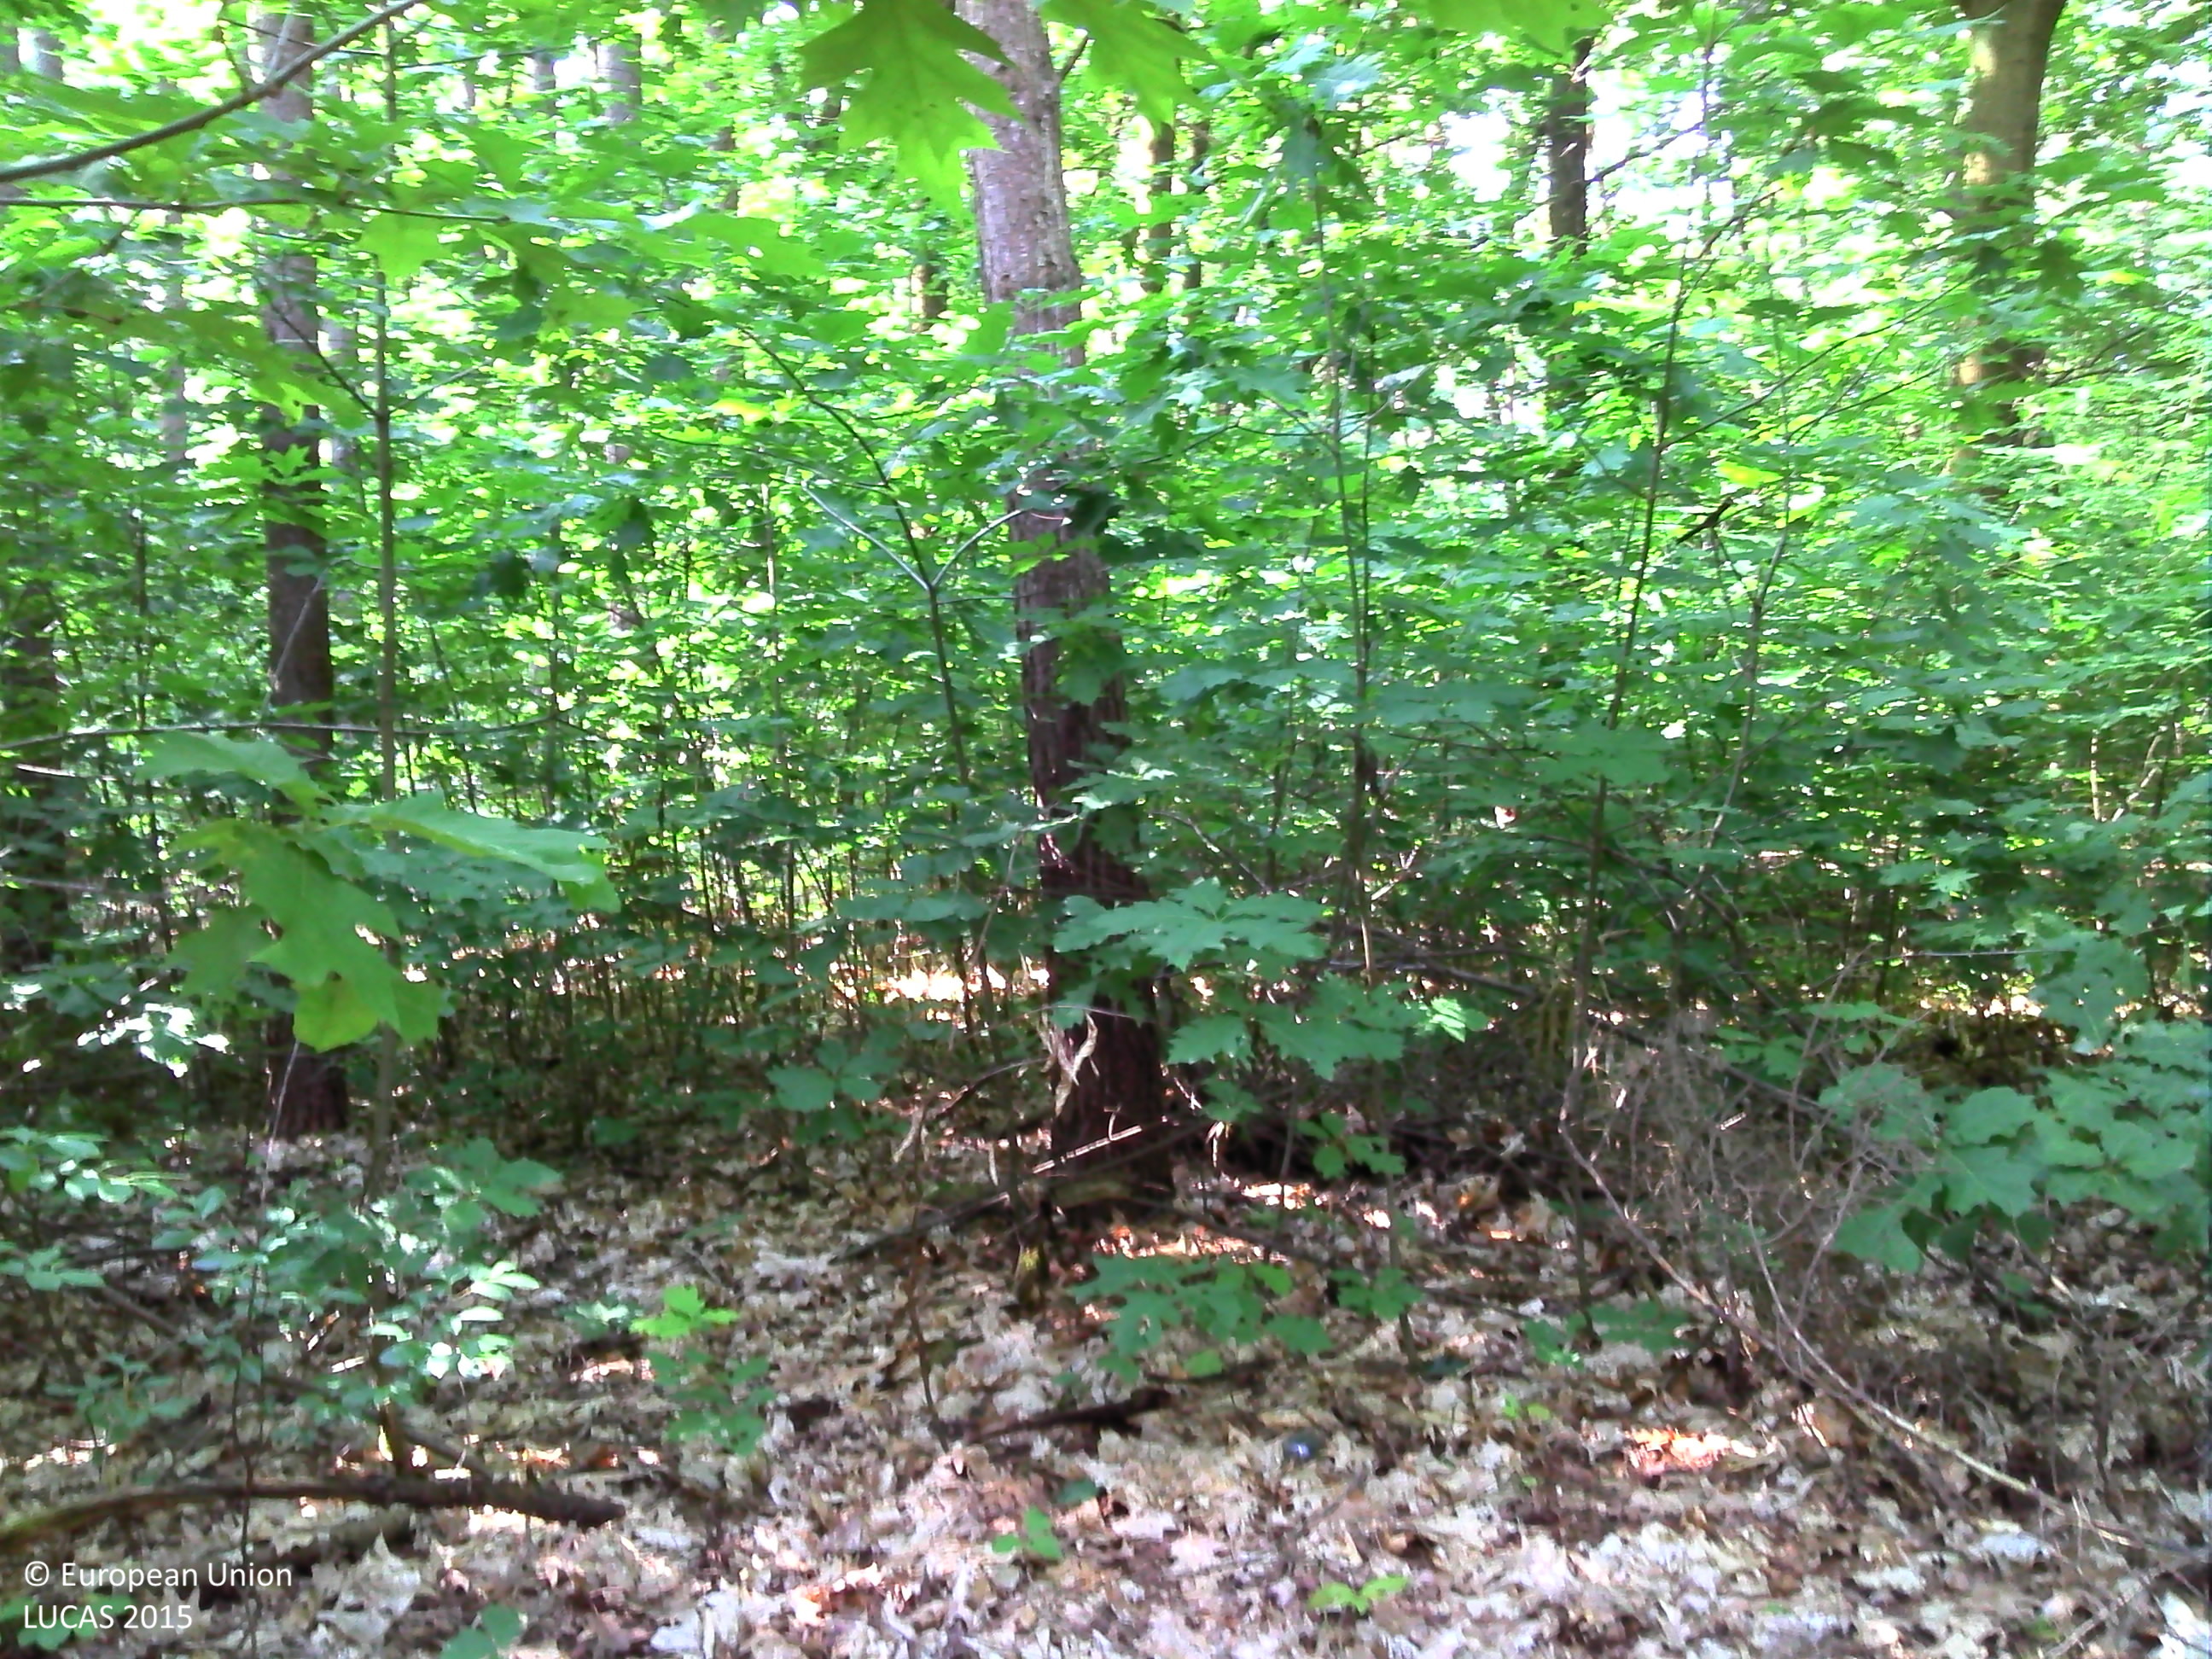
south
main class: Woodland
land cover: Pine dominated mixed woodland
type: exotic forest
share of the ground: > 75 %
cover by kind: coniferous forest trees 50 %, broadleaved forest trees 40 %, herbaceous plants 10 %
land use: Forestry
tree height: > 5 m
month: June
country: BE
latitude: 50.9087
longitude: 5.5753
